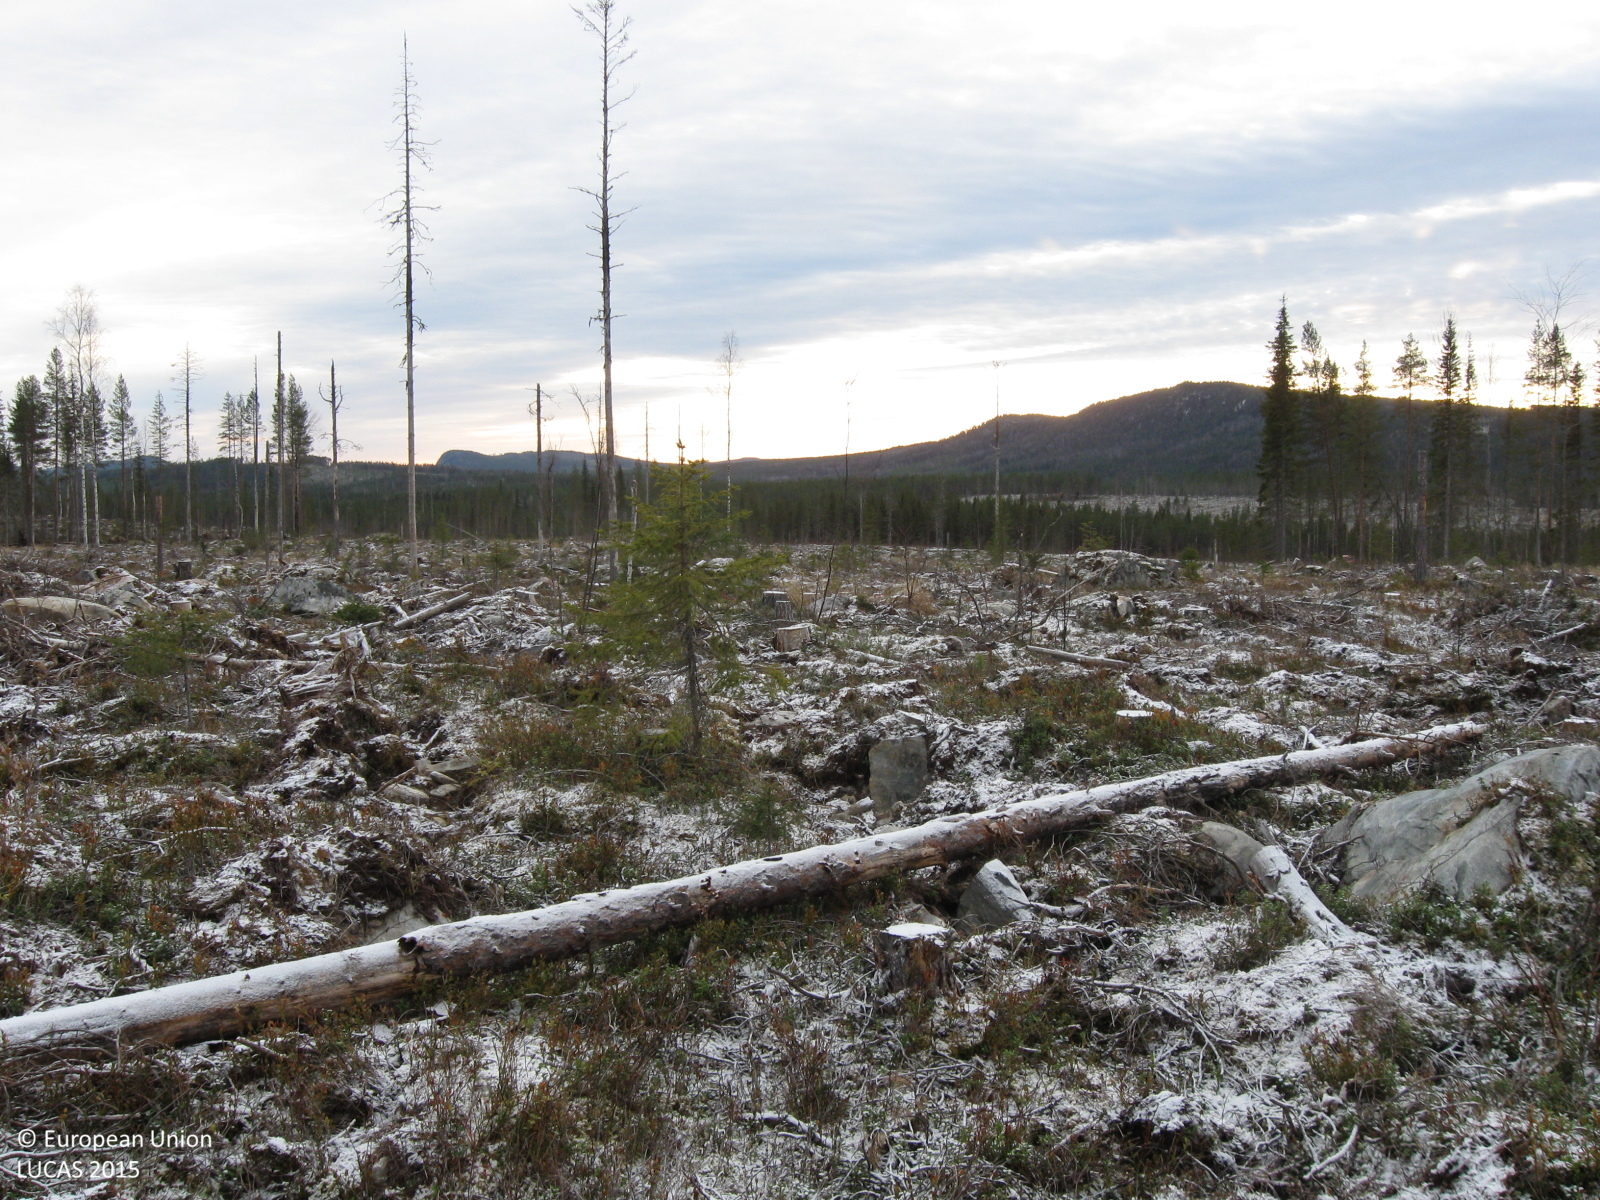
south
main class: Shrubland
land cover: Shrubland with sparse tree cover
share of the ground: 25 - 50 %
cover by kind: shrubs 45 %, consolidated bare surface 15 %, herbaceous plants 10 %, lichens and mosses 10 %, coniferous forest trees 5 %, unconsolidated bare surface 5 %
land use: Forestry
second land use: Amenities, museums, leisure
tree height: < 5 m
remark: Clear cut
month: October
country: SE
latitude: 66.2125
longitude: 21.4973
